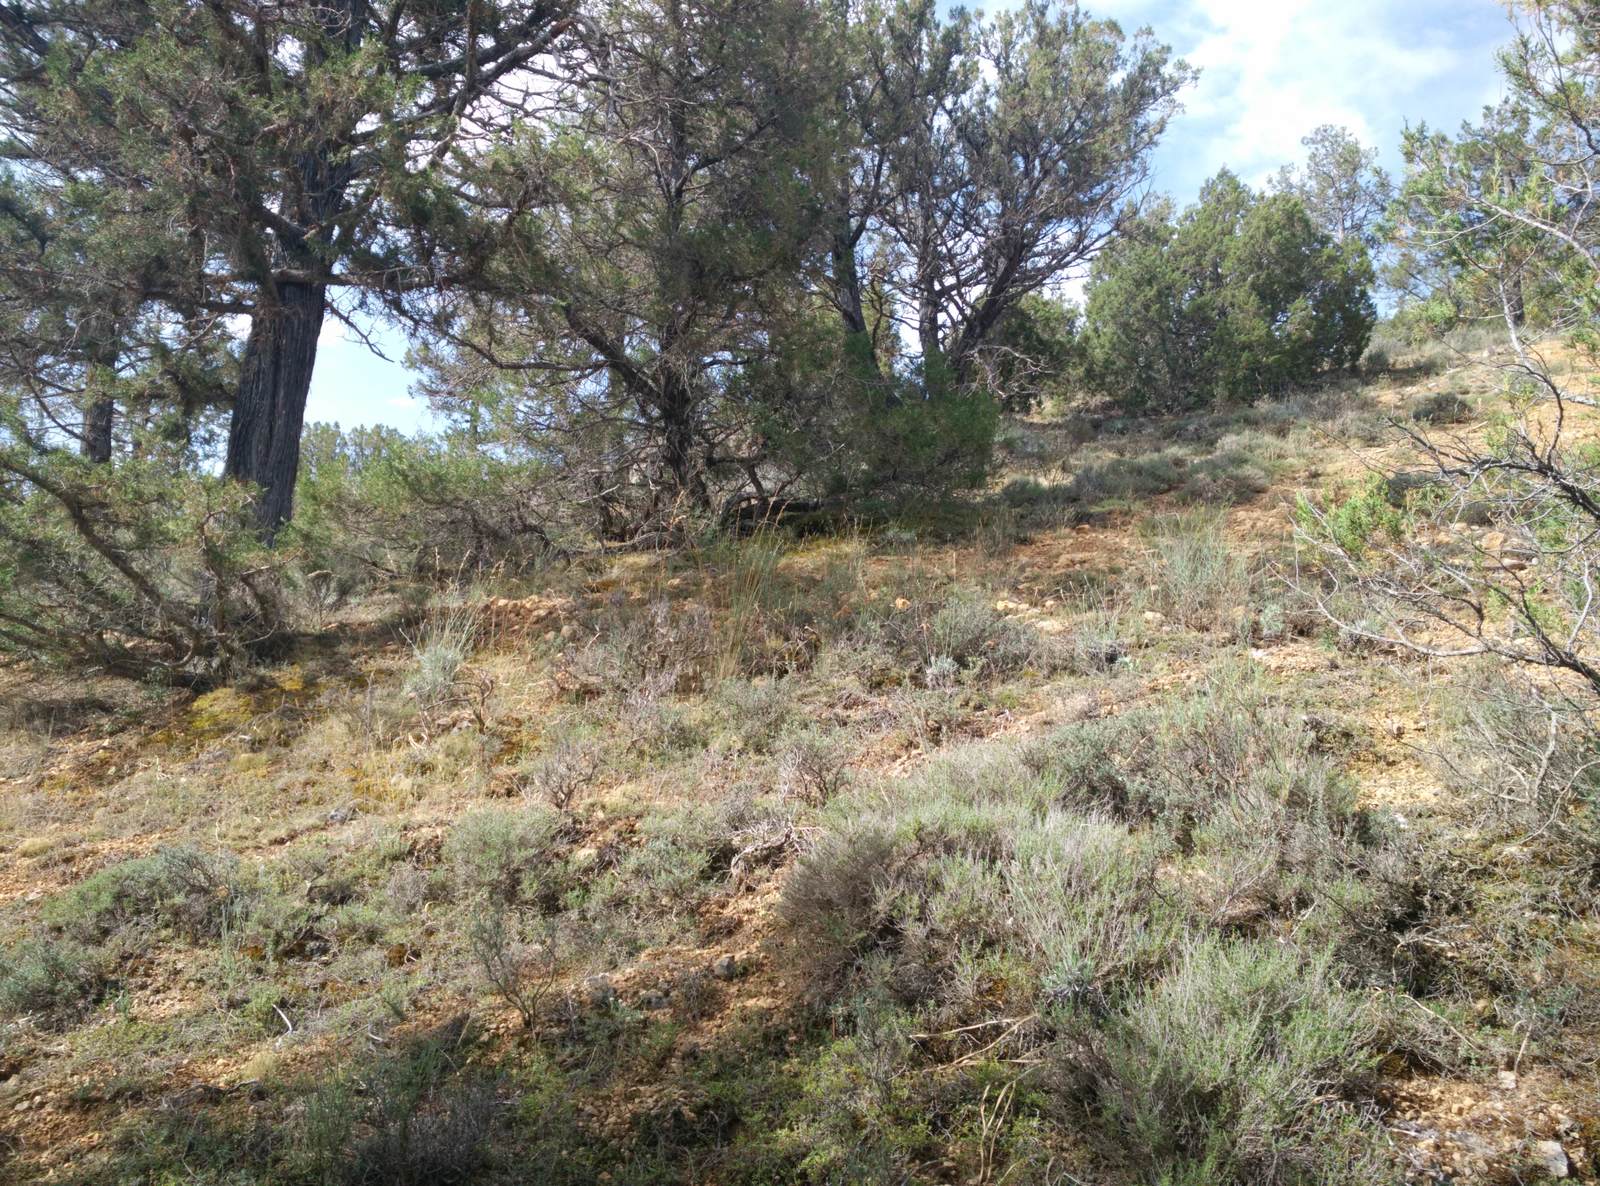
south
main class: Woodland
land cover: Other coniferous woodland
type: coniferous forest of the mediterranean region
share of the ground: 25 - 50 %
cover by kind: herbaceous plants 50 %, coniferous forest trees 30 %, shrubs 10 %, unconsolidated bare surface 10 %
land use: Semi-natural and natural areas not in use
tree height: > 5 m
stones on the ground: 10 - 25 %
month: July
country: ES
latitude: 40.8827
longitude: -1.9740
